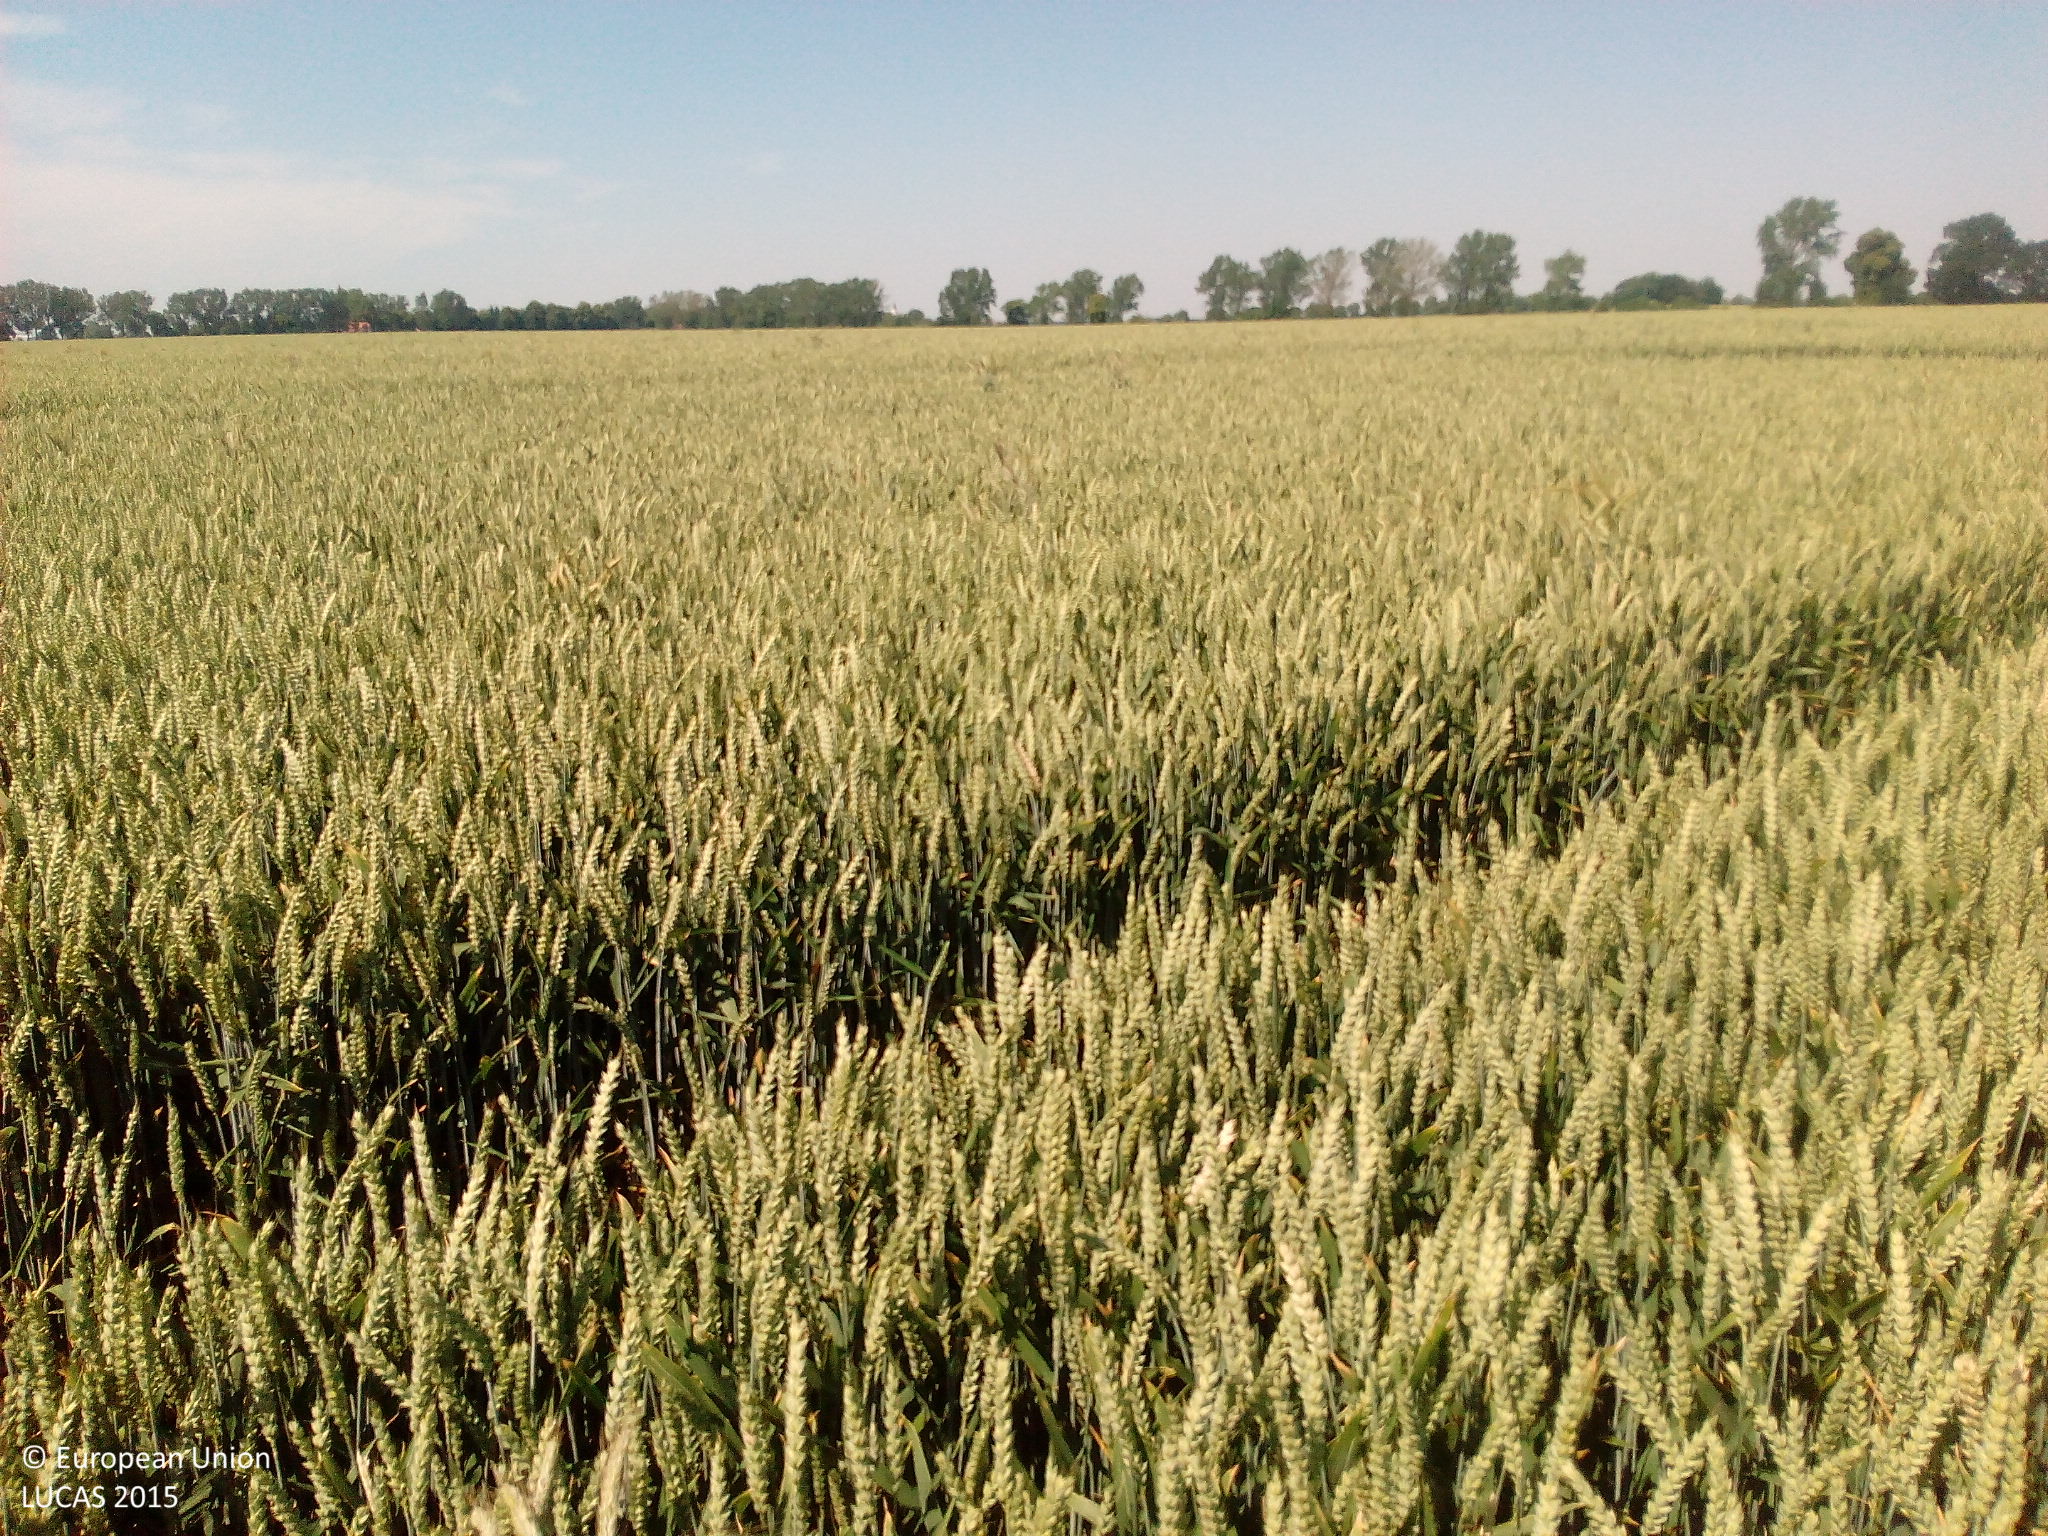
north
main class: Cropland
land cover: Common wheat
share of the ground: > 75 %
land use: Agriculture (excluding fallow land and kitchen gardens)
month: July
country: DE
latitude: 53.8795
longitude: 13.2699
